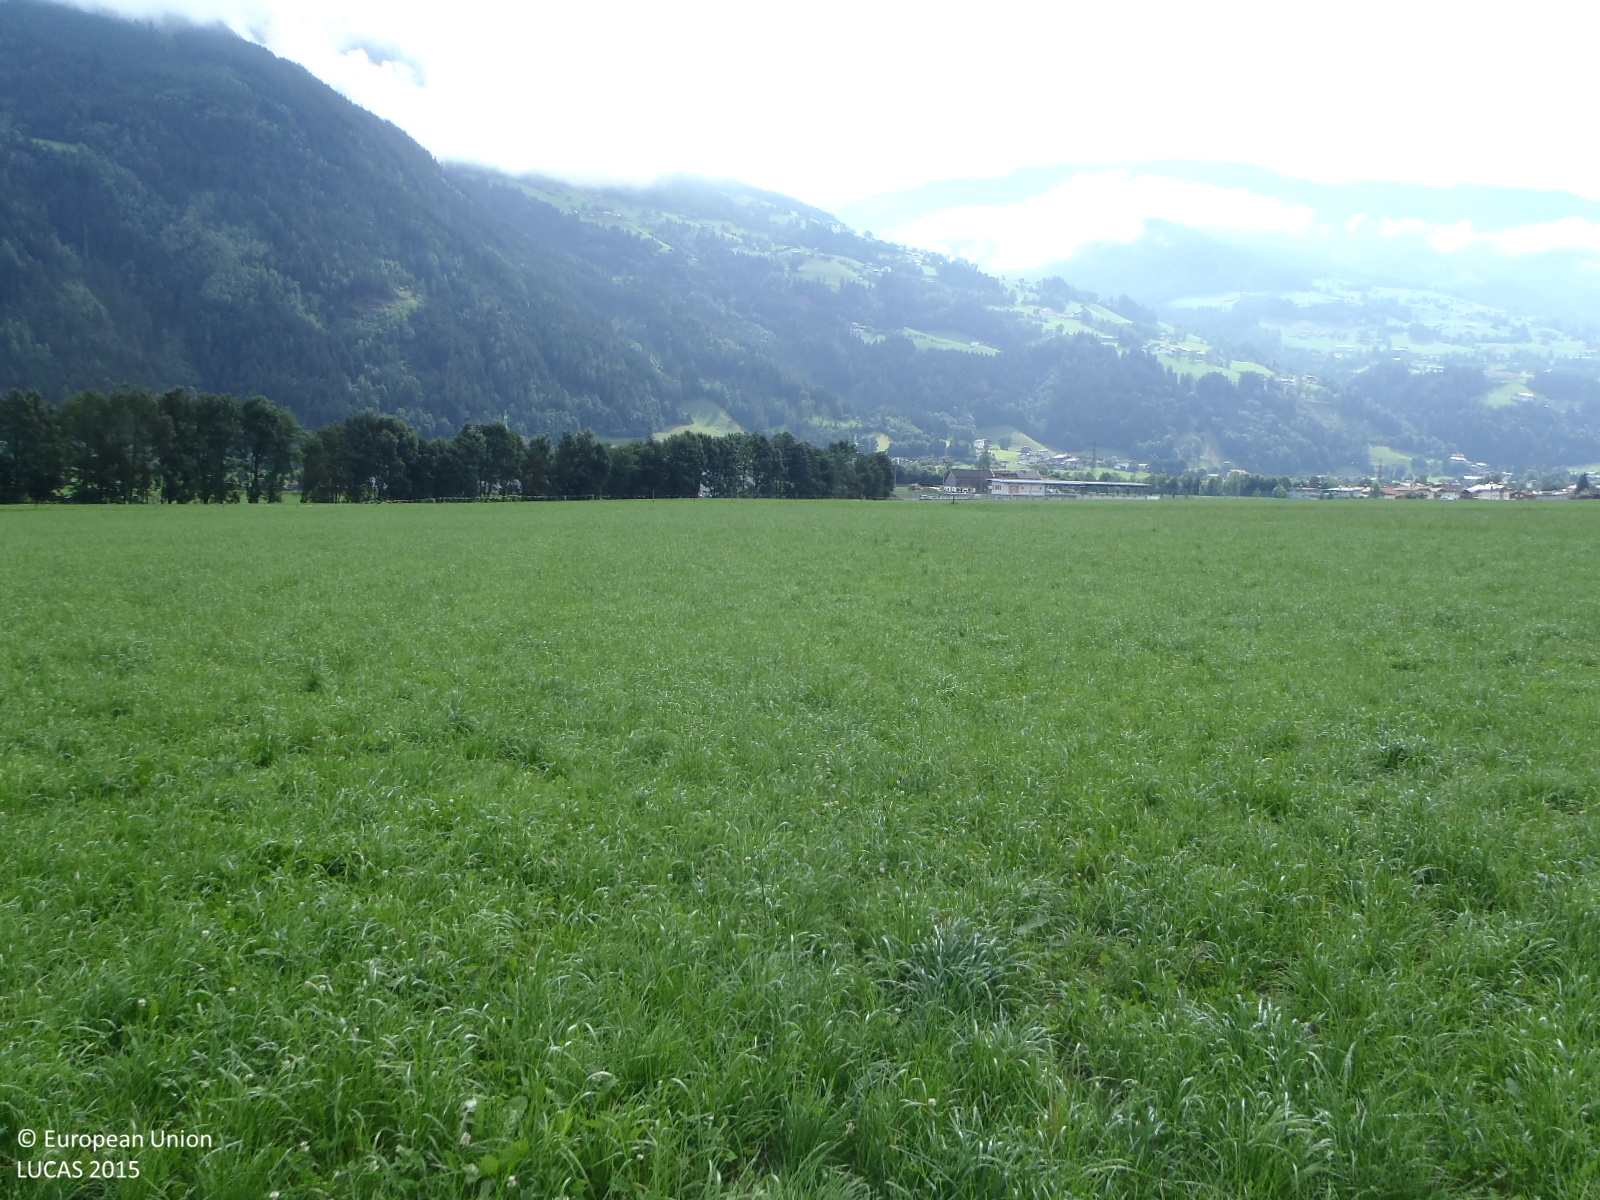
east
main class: Grassland
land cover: Grassland without tree/shrub cover
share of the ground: > 75 %
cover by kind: herbaceous plants 100 %
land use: Agriculture (excluding fallow land and kitchen gardens)
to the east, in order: Grassland without tree/shrub cover; Fences; Paved roads, cycling and walking lanes; Grassland without tree/shrub cover
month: July
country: AT
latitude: 47.3076
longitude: 11.8635
